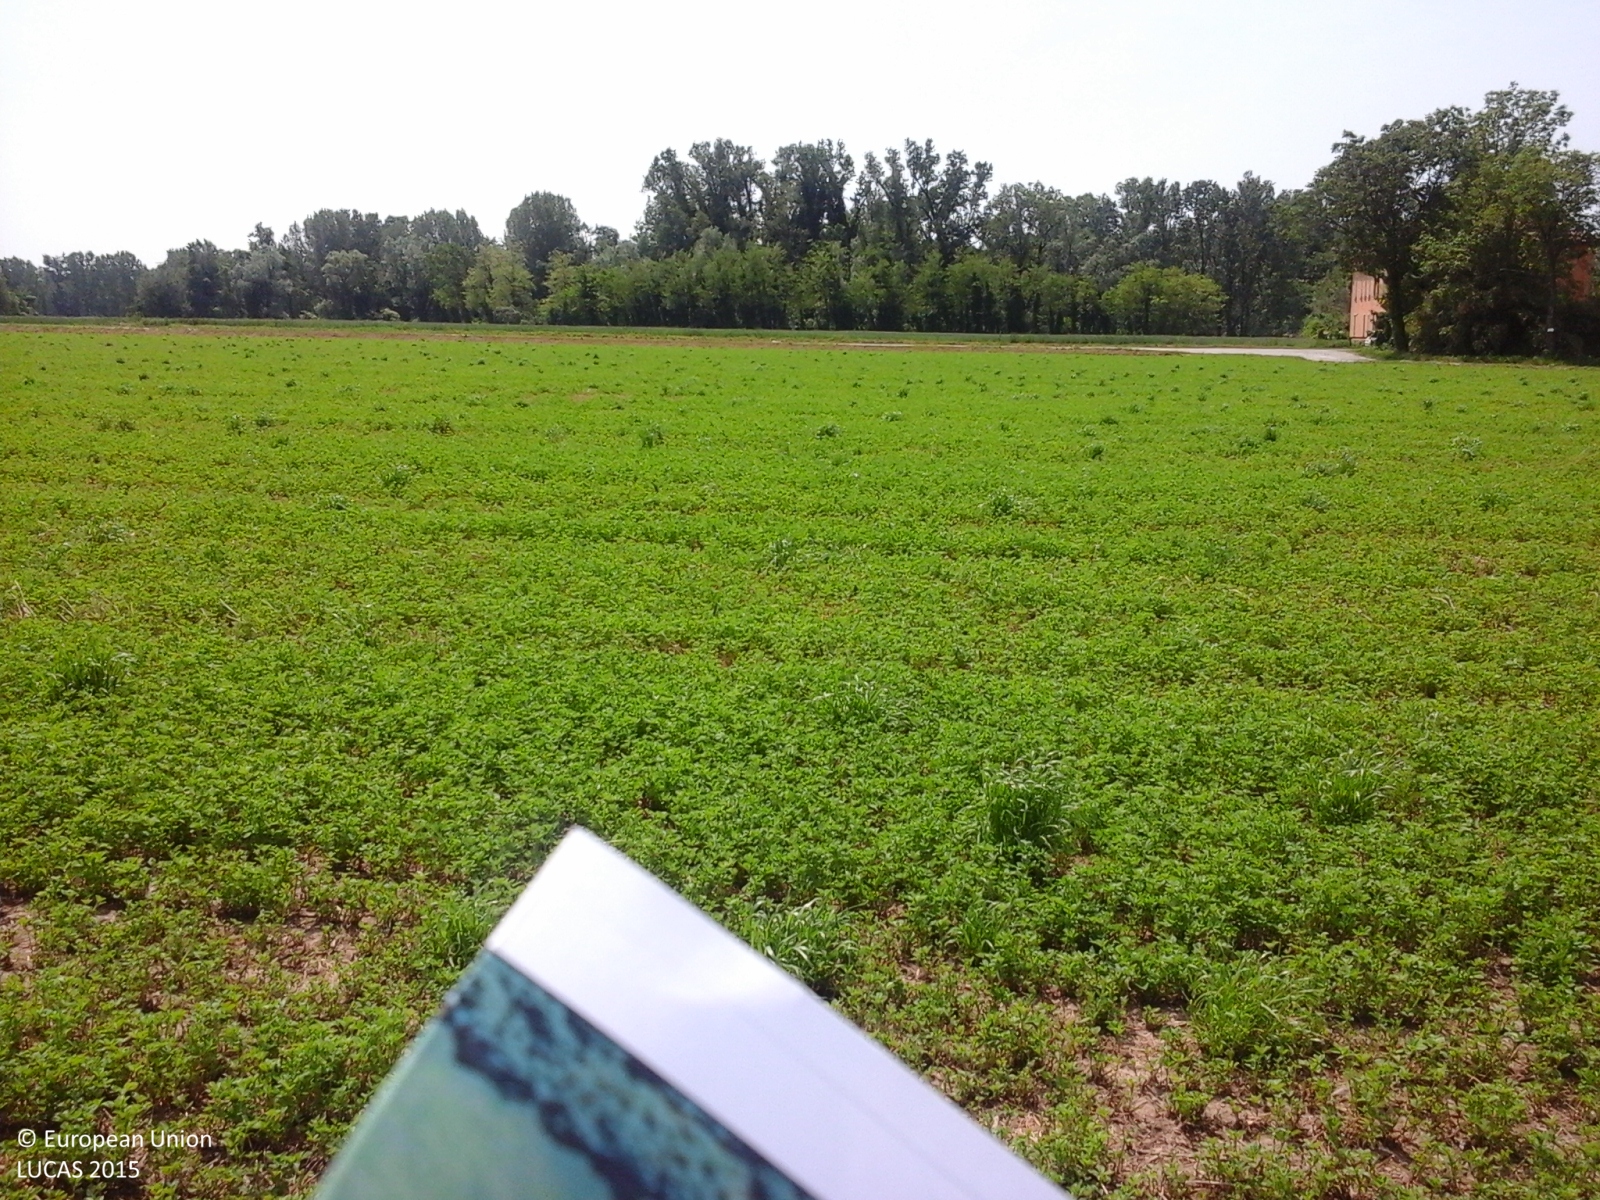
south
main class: Cropland
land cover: Lucerne
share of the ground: > 75 %
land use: Agriculture (excluding fallow land and kitchen gardens)
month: May
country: IT
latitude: 45.3421
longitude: 9.9108
